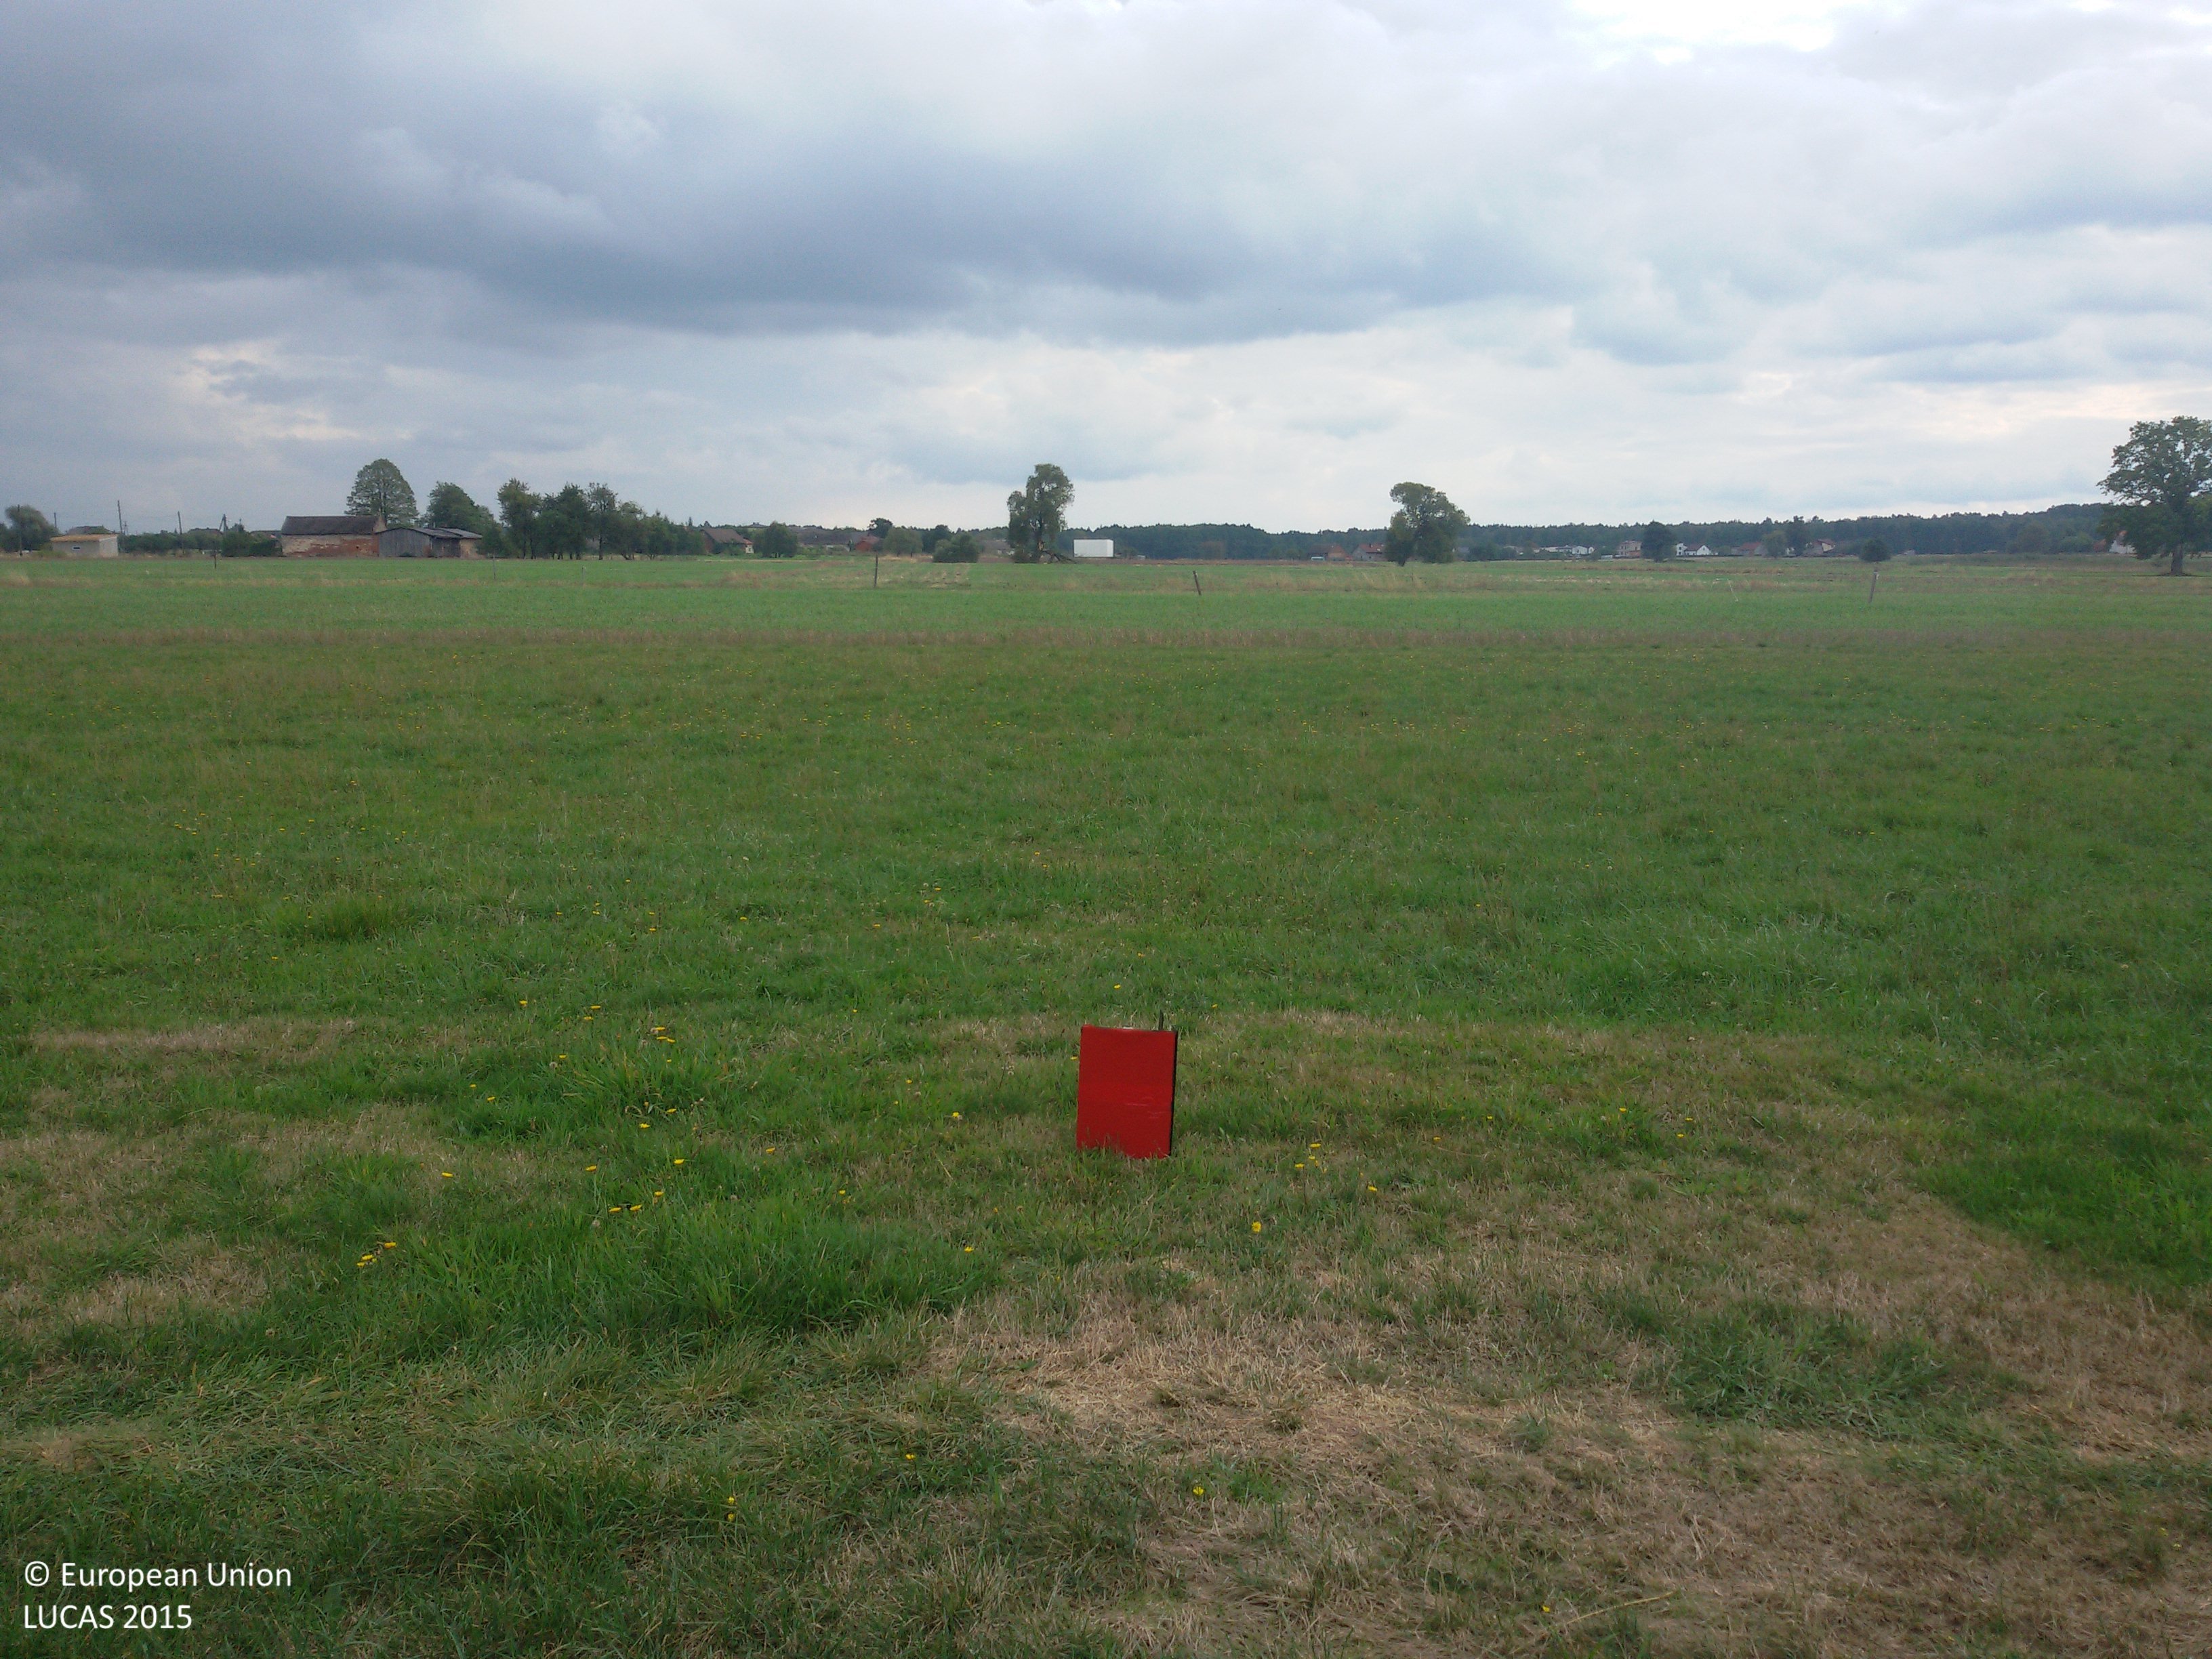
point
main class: Grassland
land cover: Grassland without tree/shrub cover
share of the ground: > 75 %
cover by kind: herbaceous plants 100 %
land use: Agriculture (excluding fallow land and kitchen gardens)
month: September
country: PL
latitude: 50.7348
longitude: 18.7350
